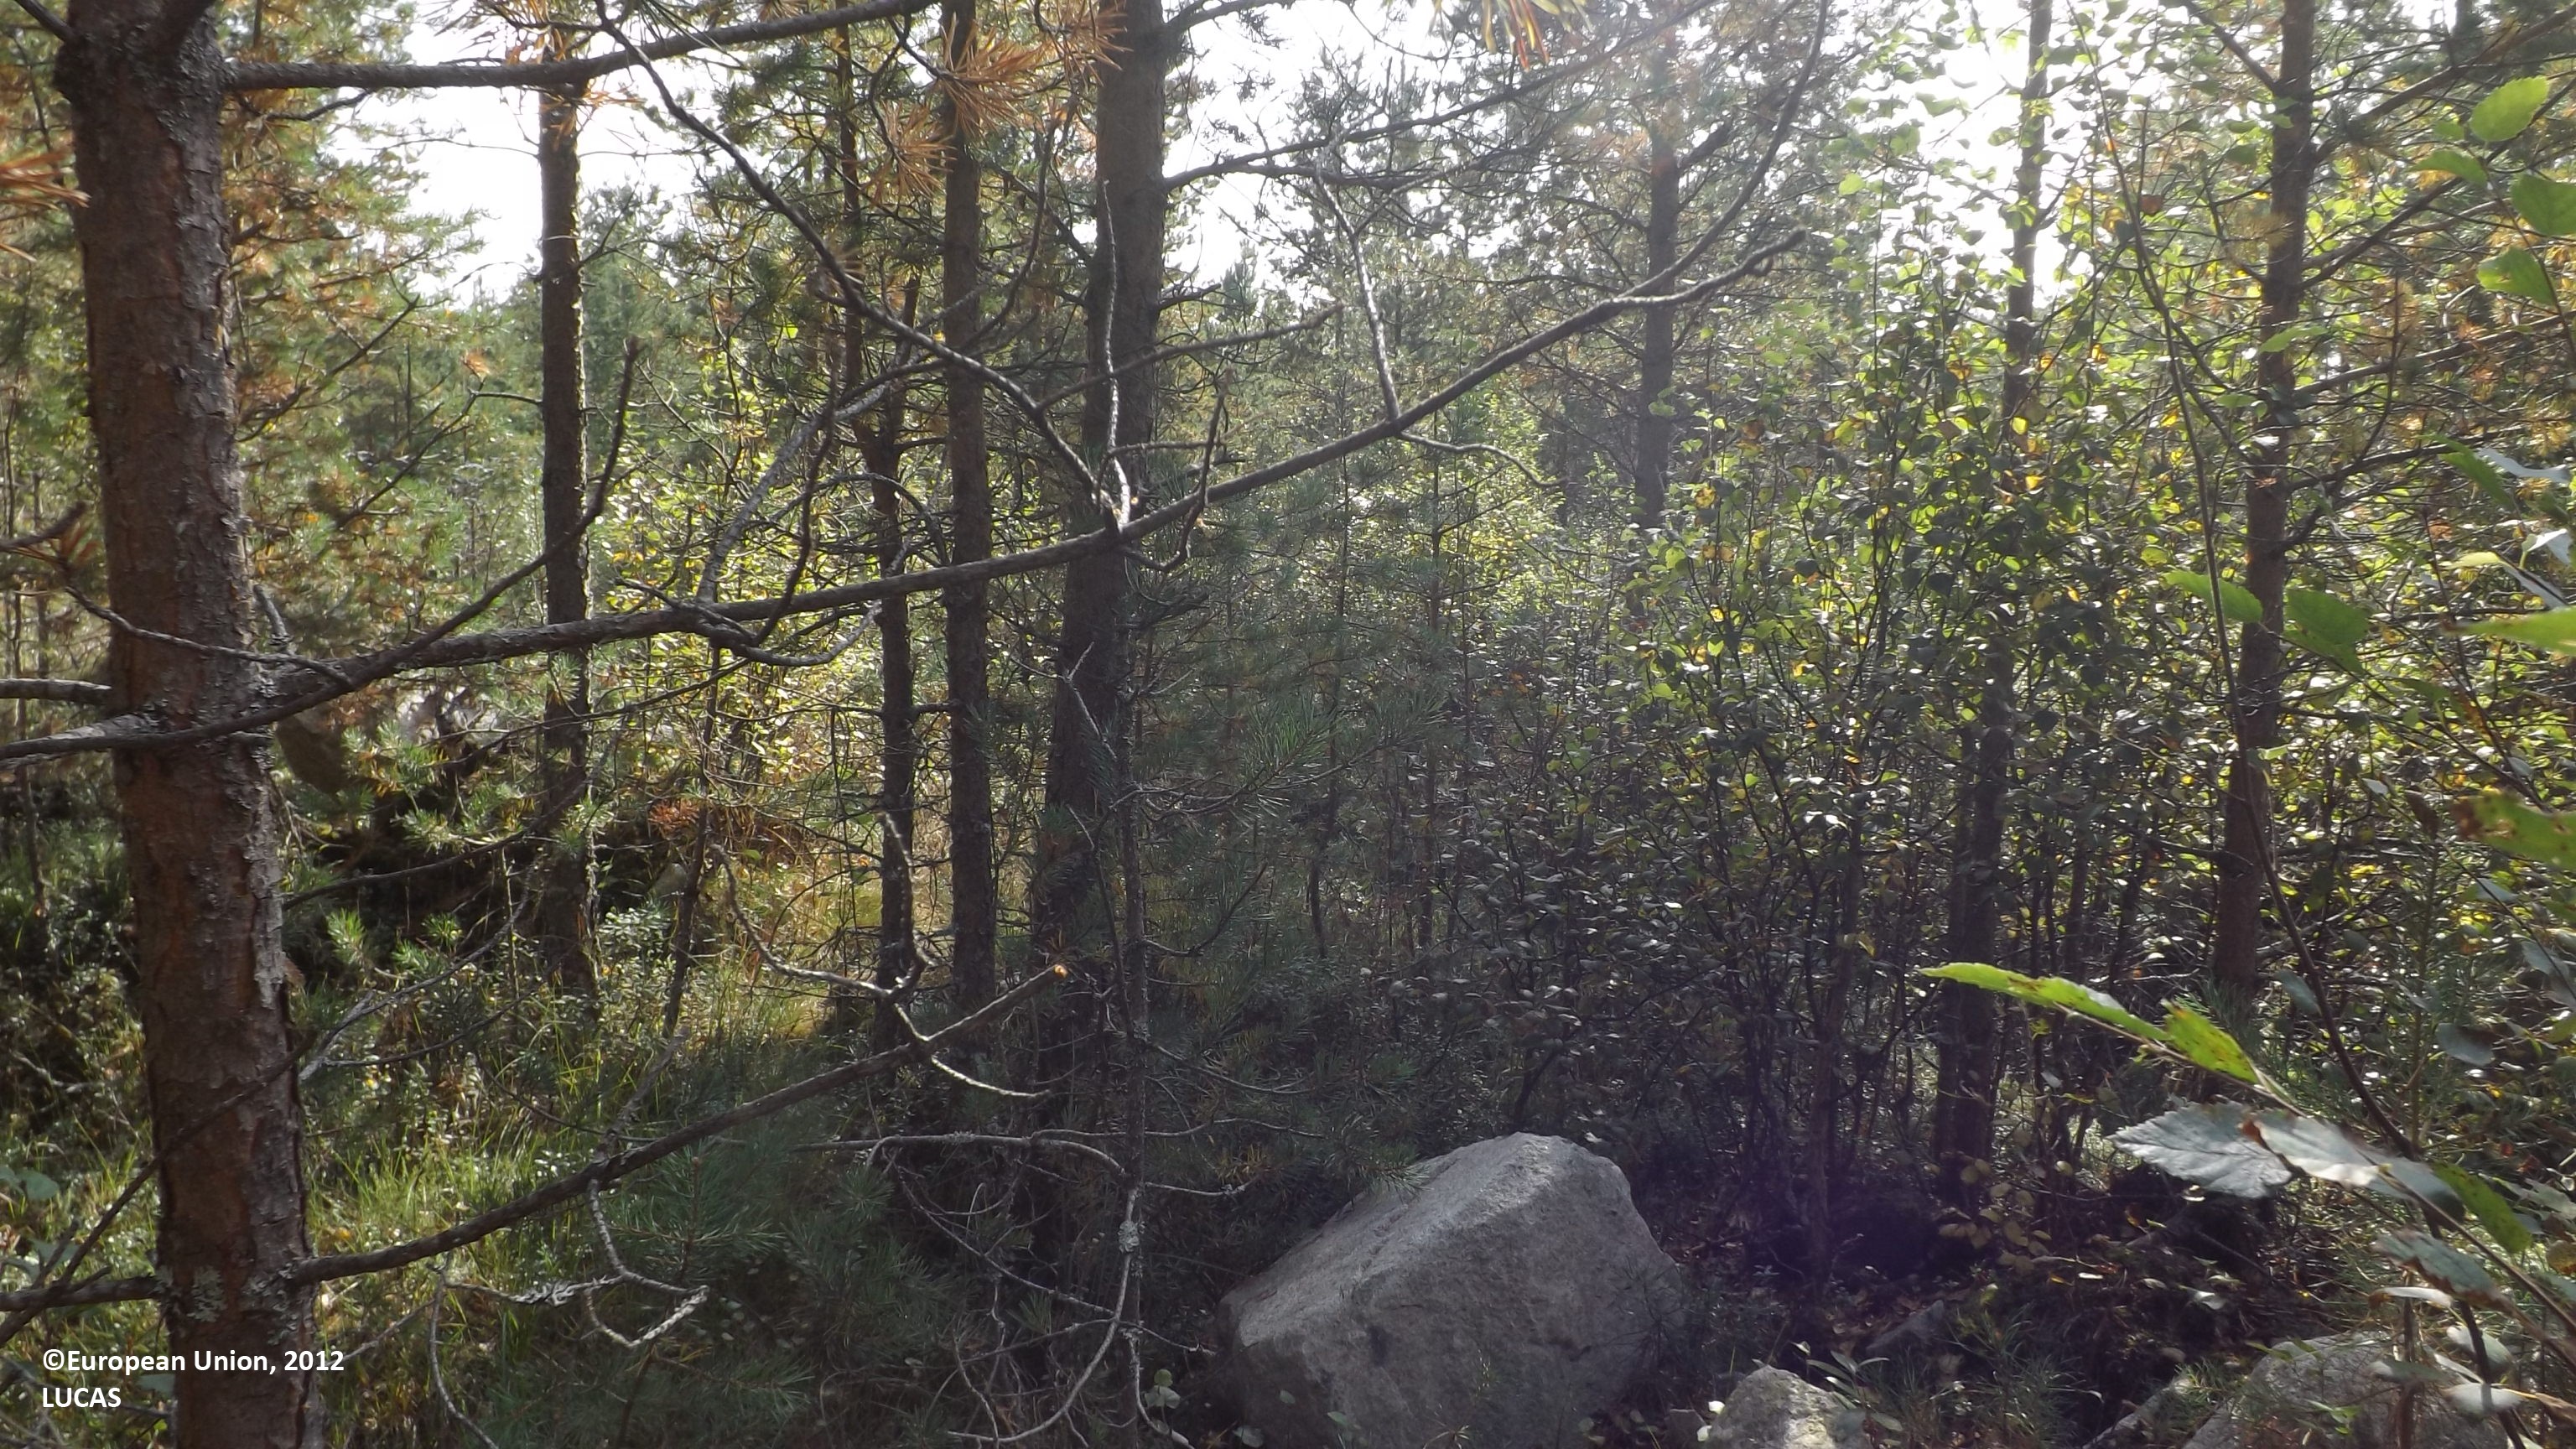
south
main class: Woodland
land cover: Pine dominated coniferous woodland
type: boreal forest
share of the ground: 50 - 75 %
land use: Forestry
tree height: > 5 m
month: August
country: FI
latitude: 63.7347
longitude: 23.6115
